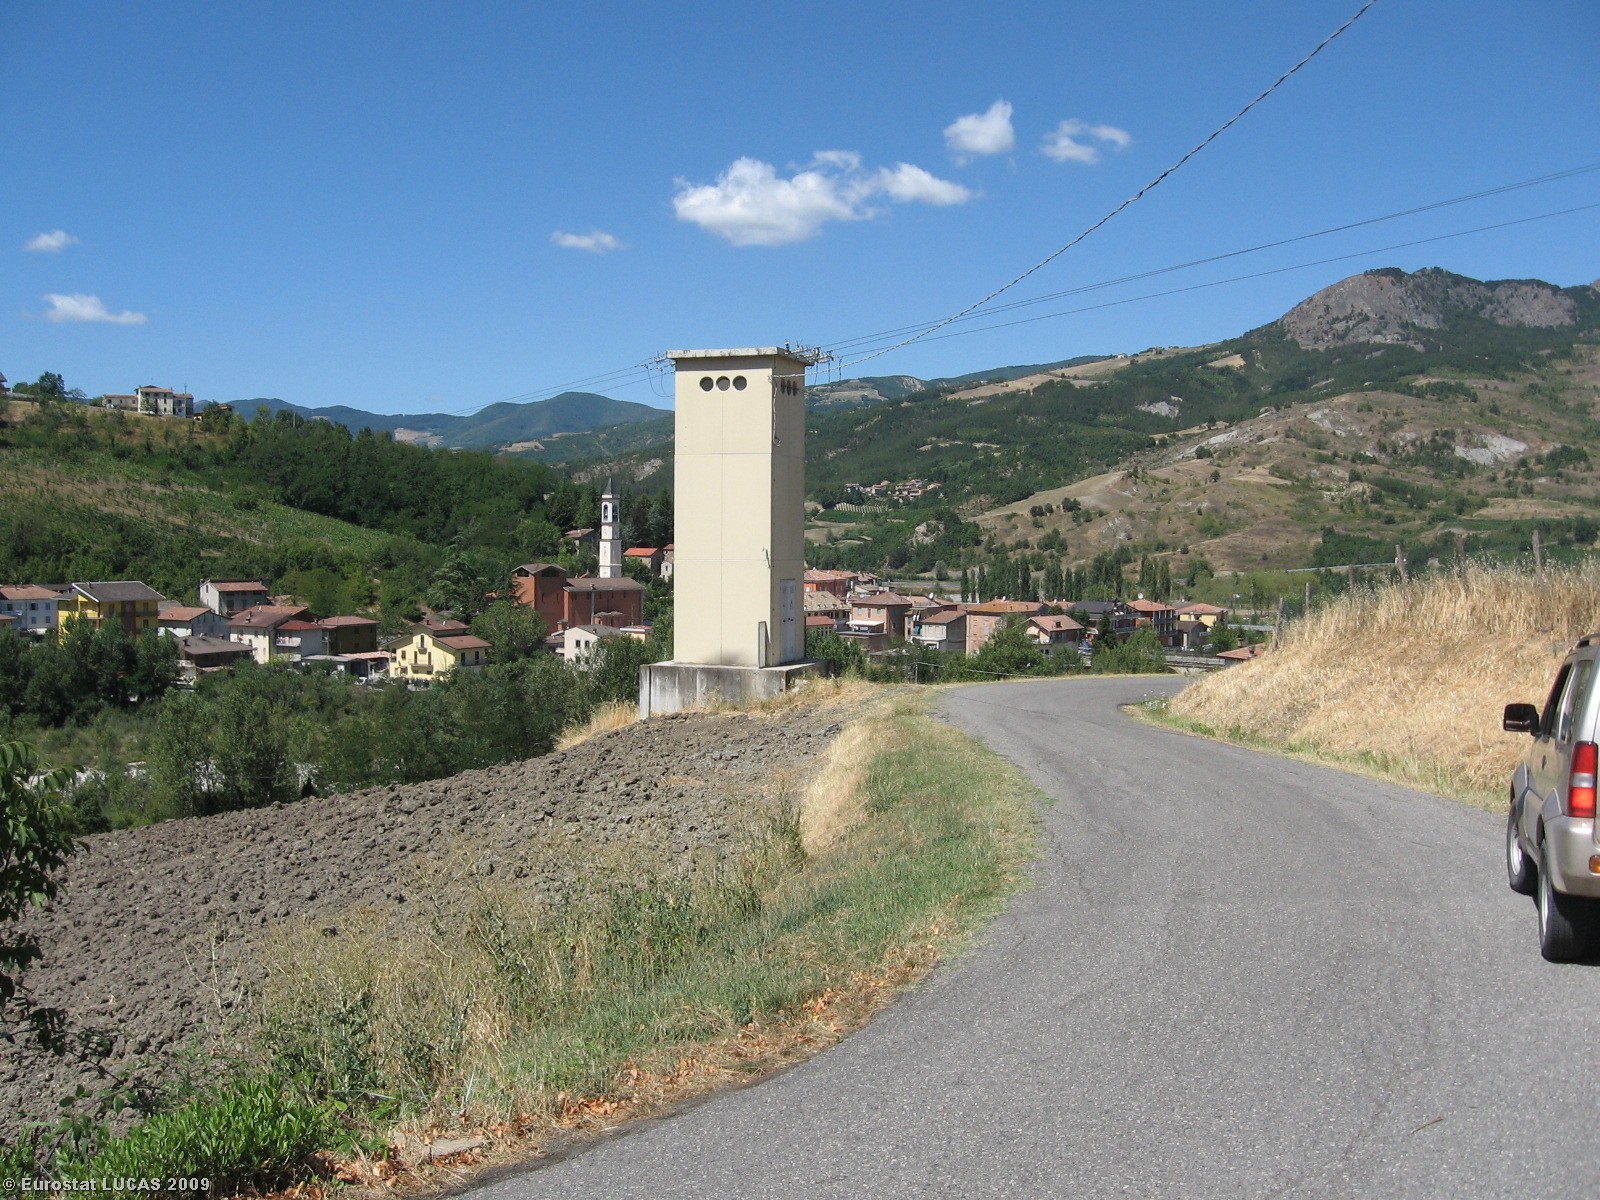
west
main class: Grassland
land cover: Grassland without tree/shrub cover
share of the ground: > 75 %
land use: Agriculture (excluding fallow land and kitchen gardens)
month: August
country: IT
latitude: 44.8182
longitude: 9.5078
